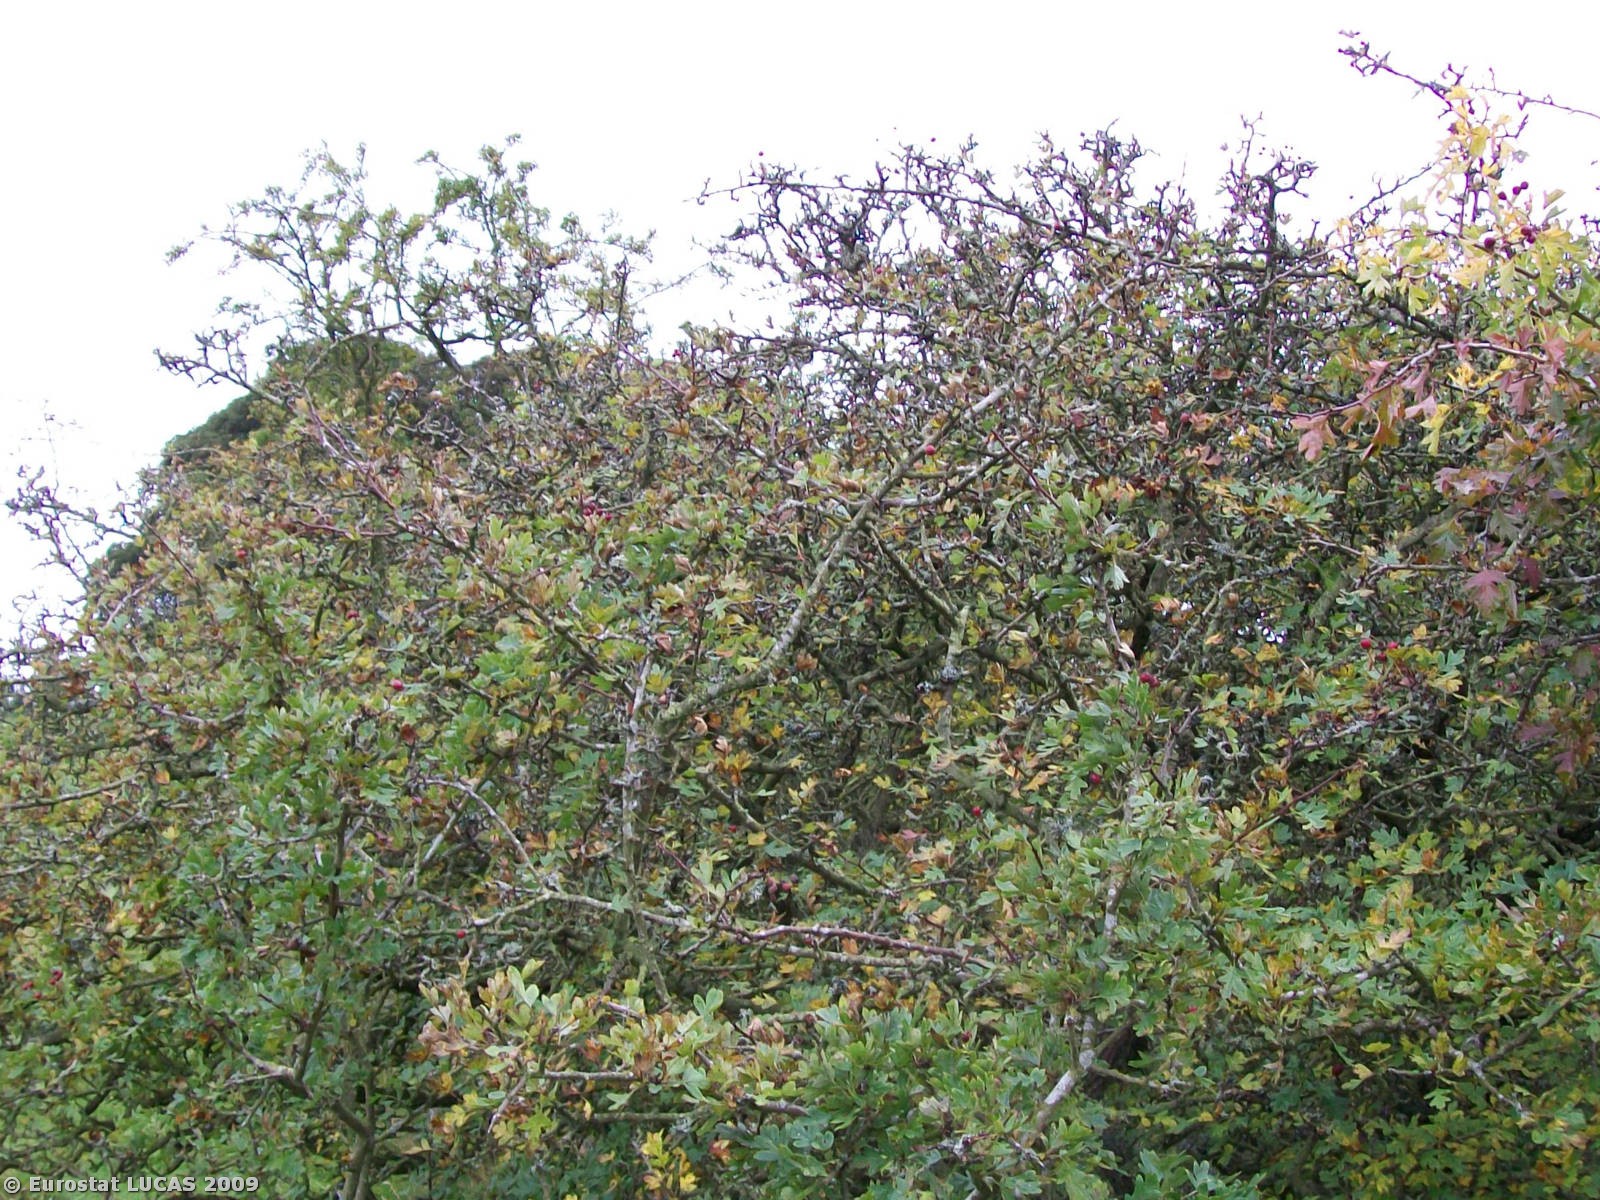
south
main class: Woodland
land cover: Broadleaved woodland
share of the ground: > 75 %
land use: Agriculture (excluding fallow land and kitchen gardens)
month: September
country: GB
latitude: 55.0315
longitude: -2.0870
